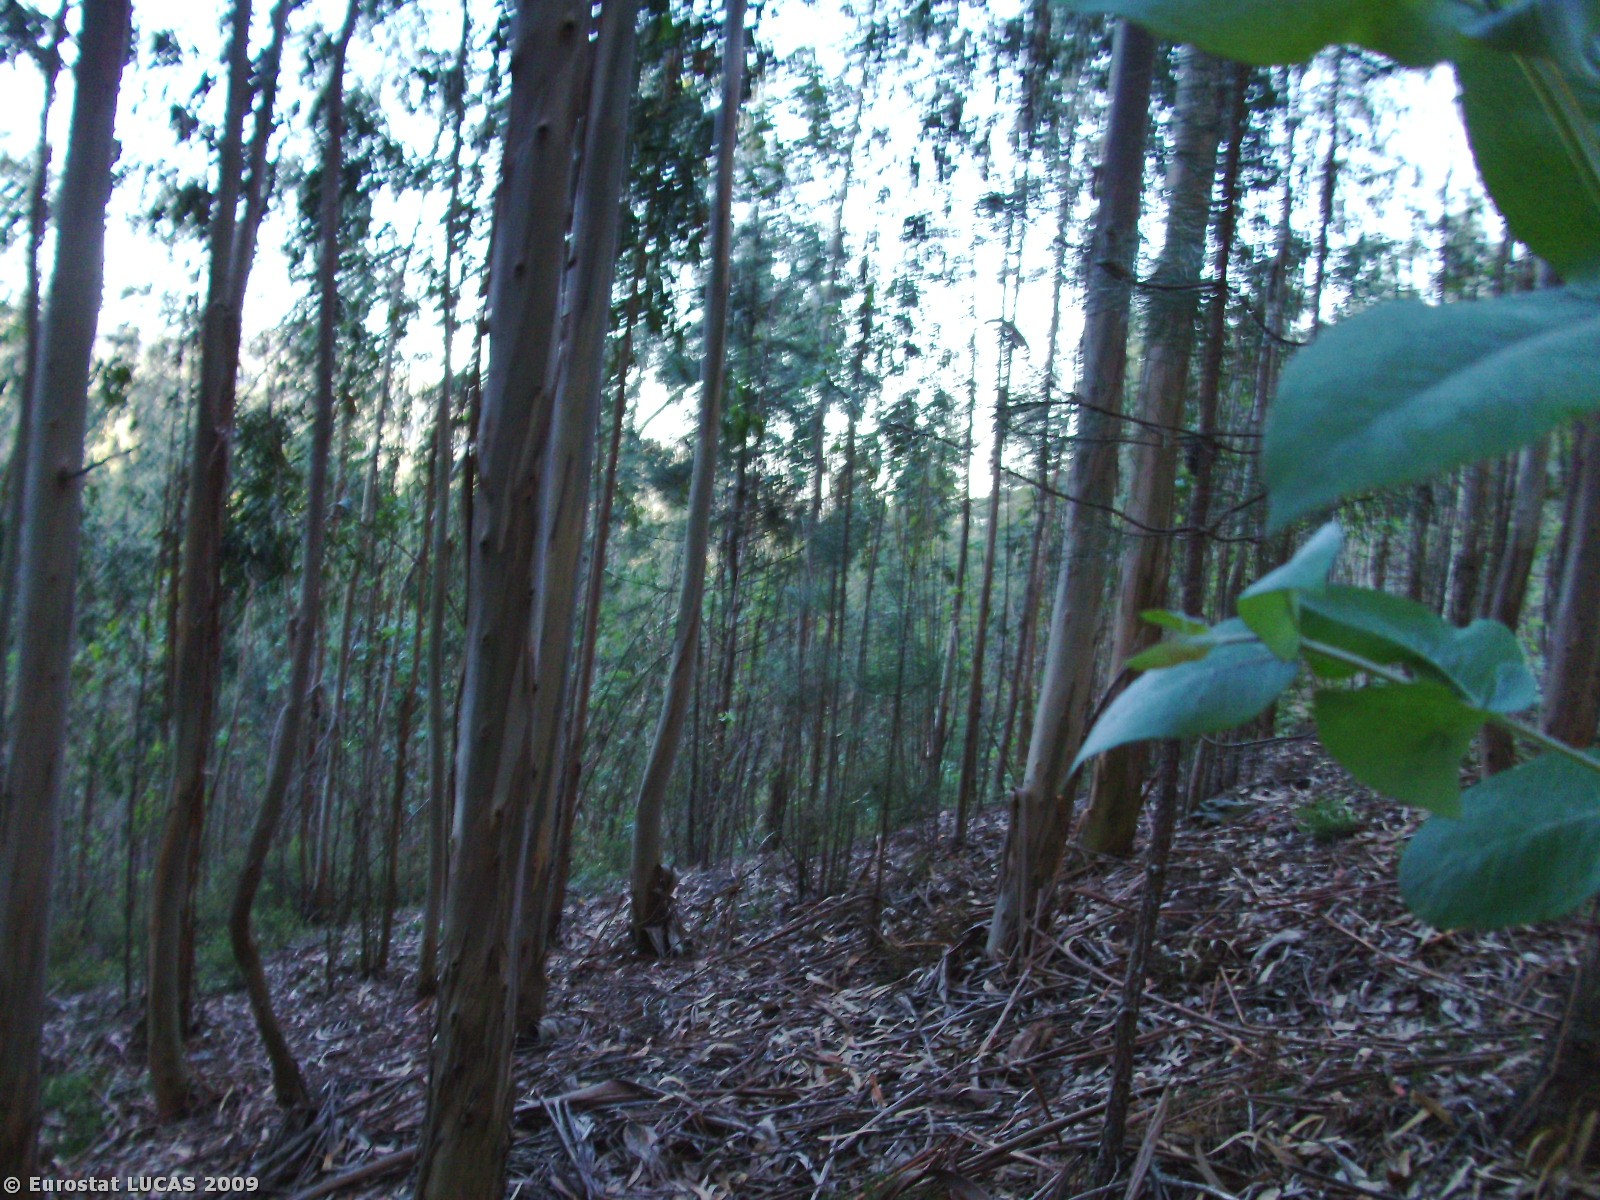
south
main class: Woodland
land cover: Broadleaved woodland
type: plantations and self-sown exotic forest
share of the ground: > 75 %
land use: Forestry
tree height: > 5 m
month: May
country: PT
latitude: 40.7757
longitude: -8.4471
